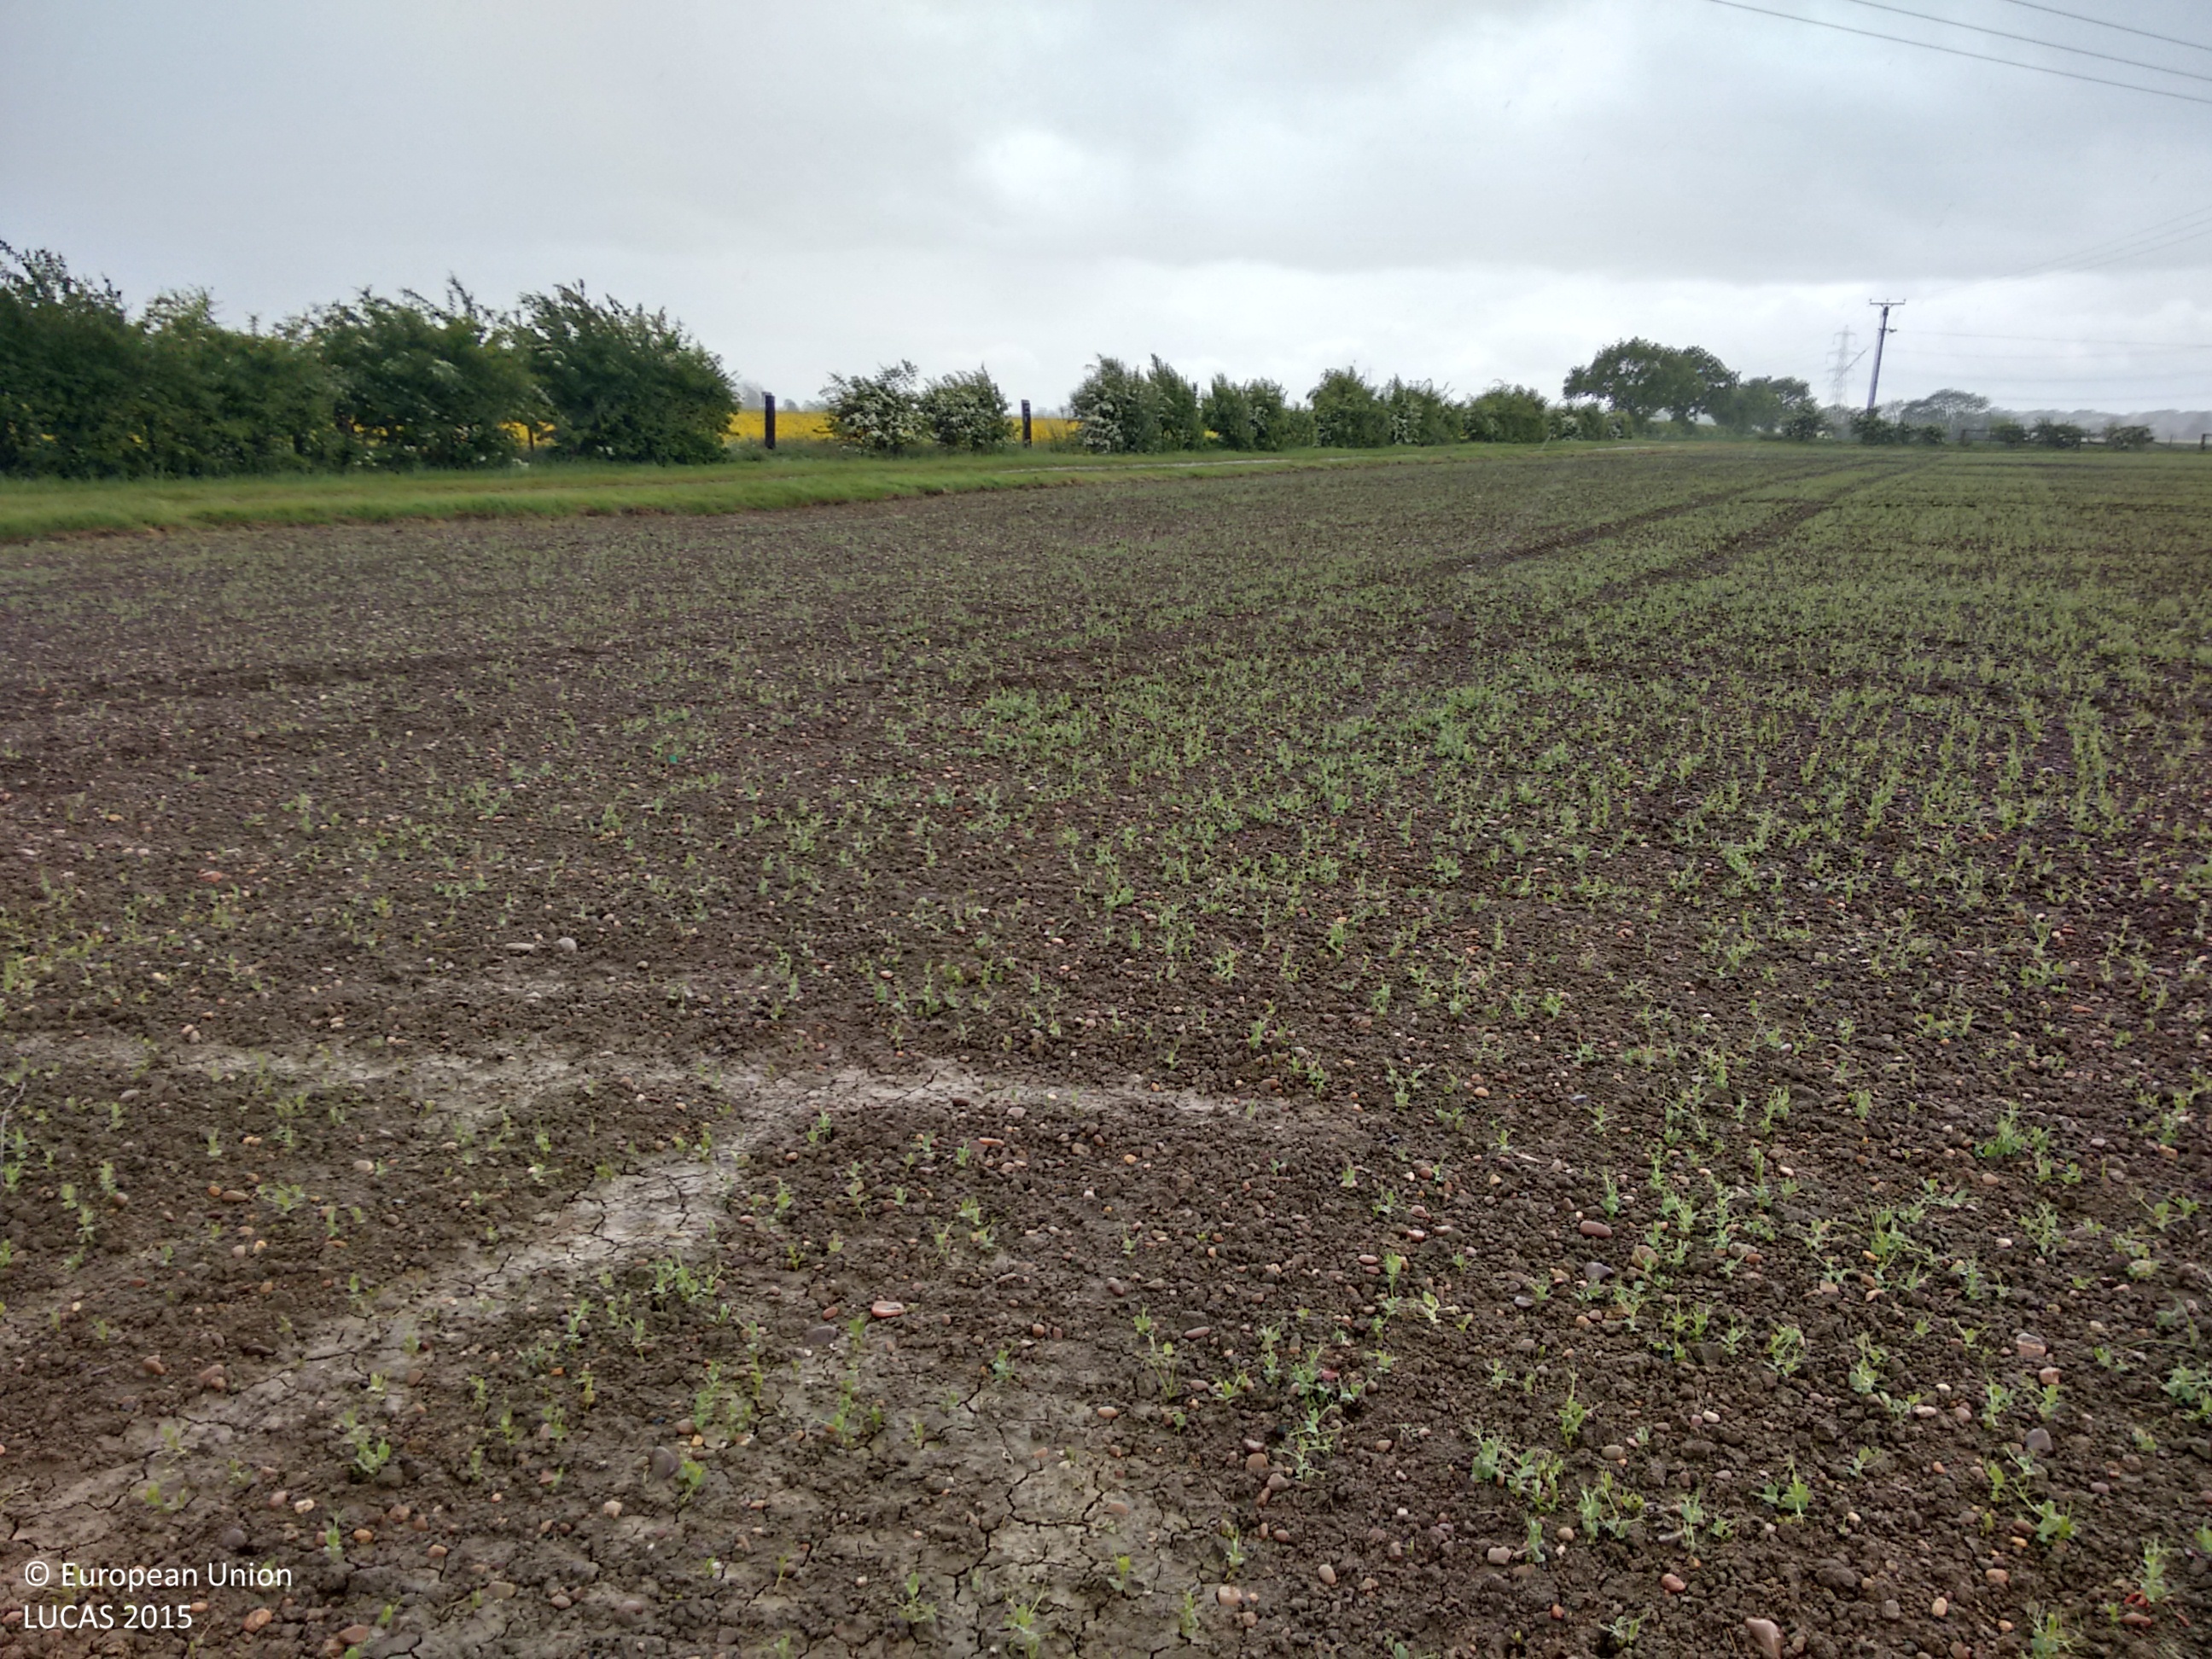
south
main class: Cropland
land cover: Dry pulses
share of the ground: 10 - 25 %
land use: Agriculture (excluding fallow land and kitchen gardens)
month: May
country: GB
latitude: 53.5661
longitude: -1.0511
